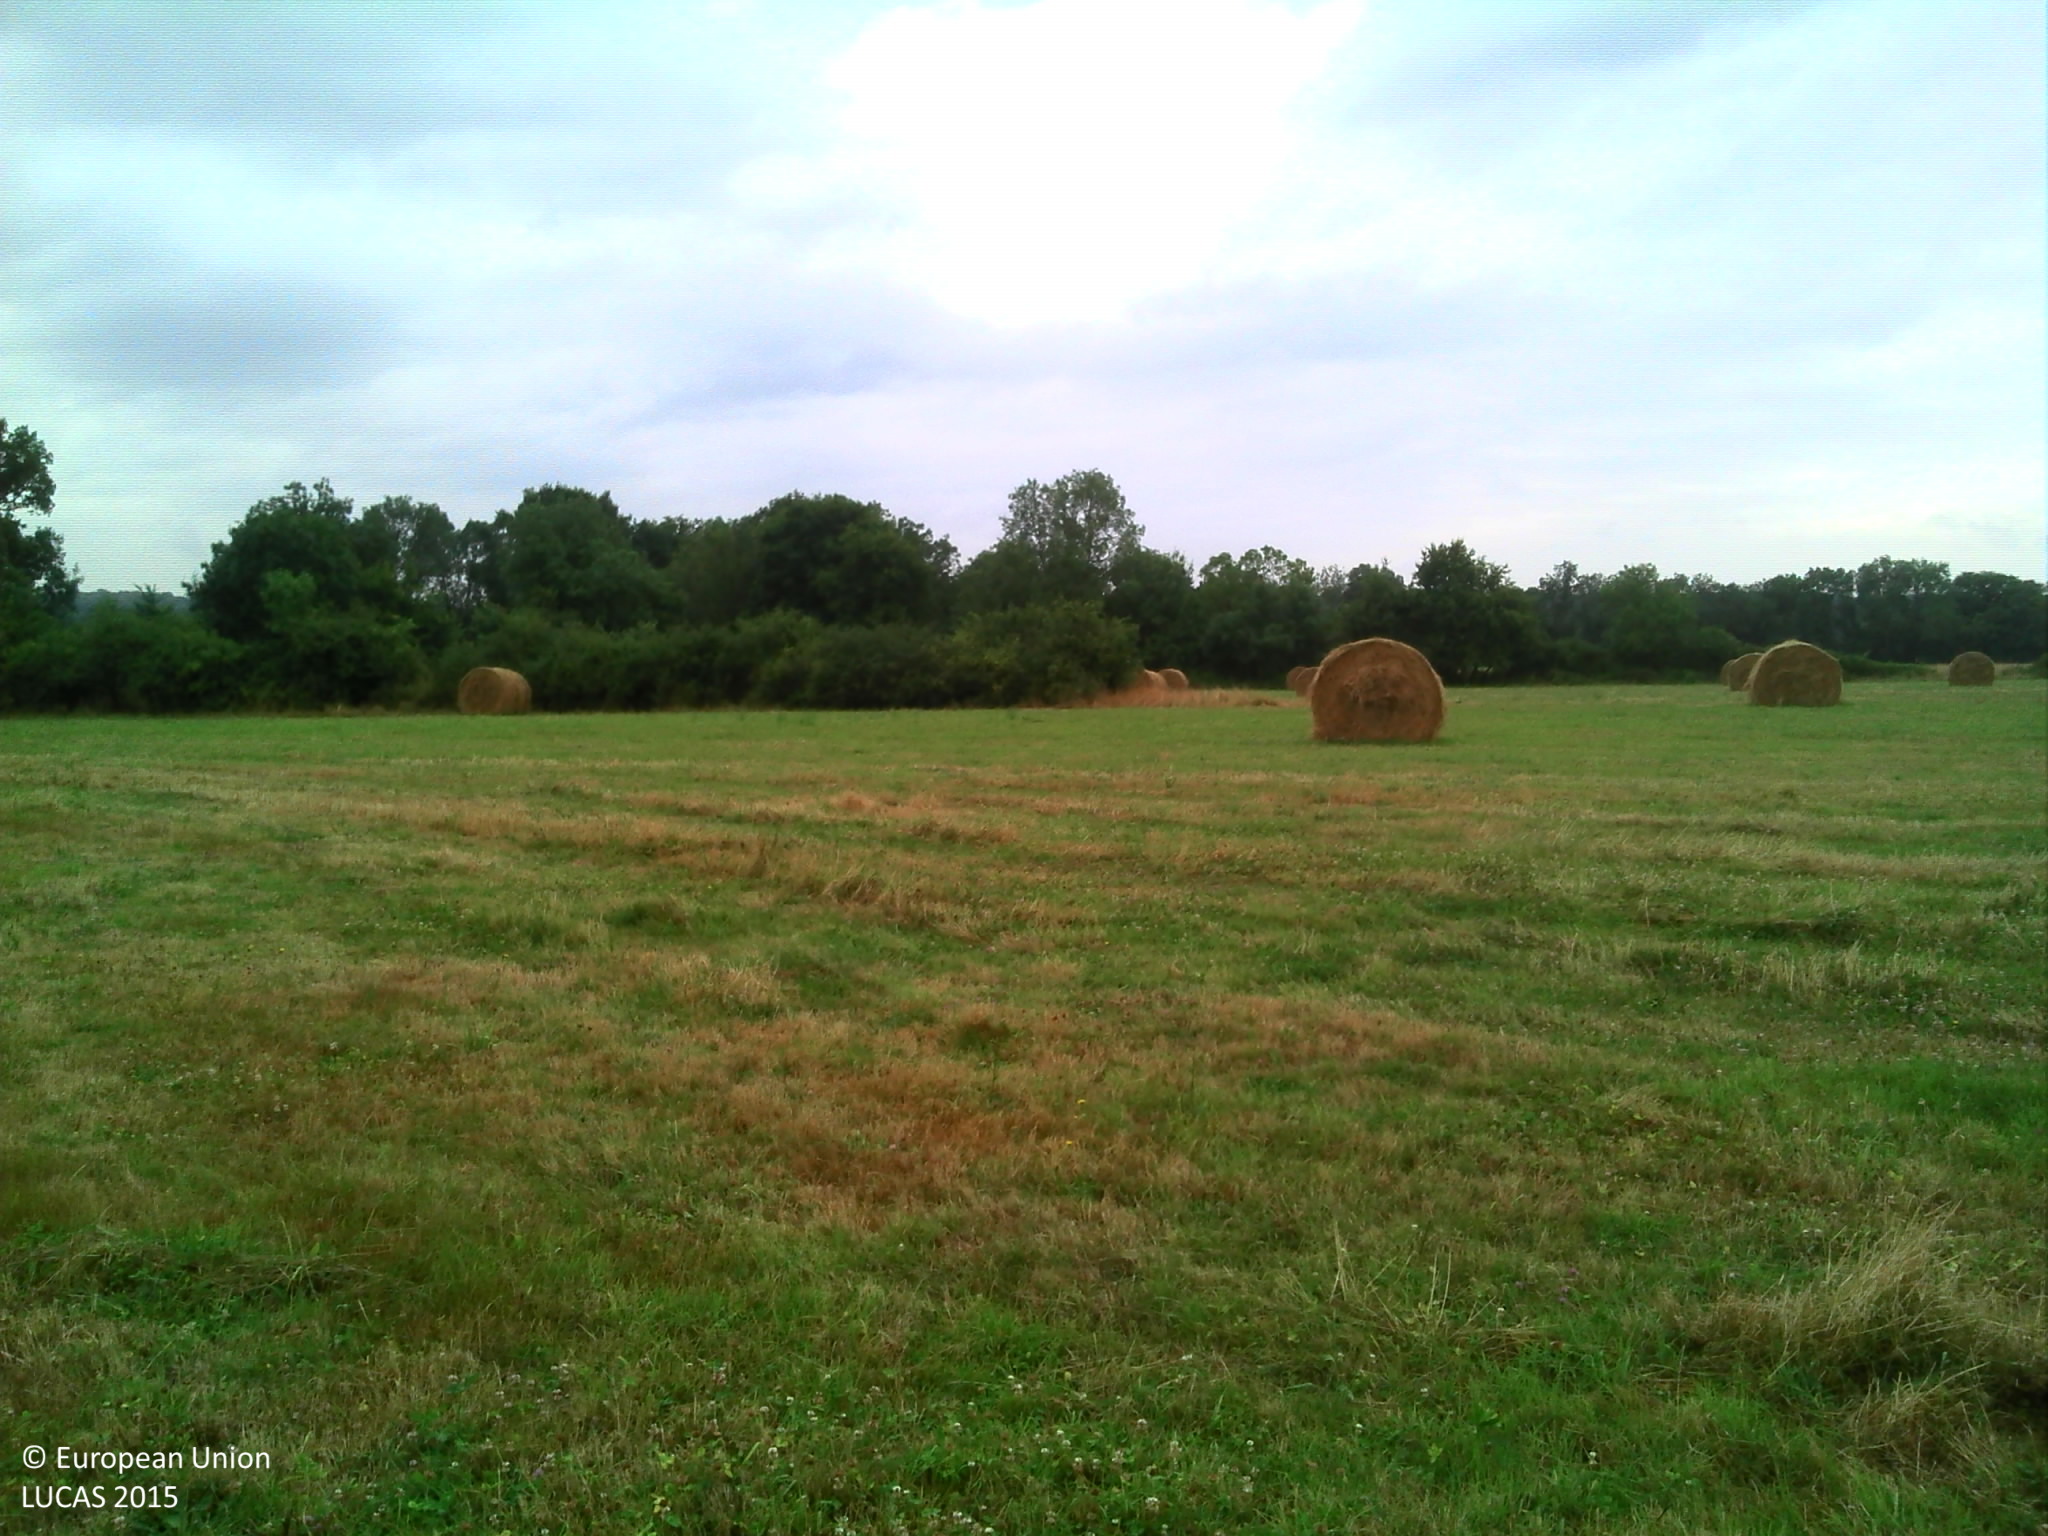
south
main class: Grassland
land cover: Grassland without tree/shrub cover
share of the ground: > 75 %
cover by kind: herbaceous plants 100 %
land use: Agriculture (excluding fallow land and kitchen gardens)
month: July
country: FR
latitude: 47.1839
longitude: -1.8300
